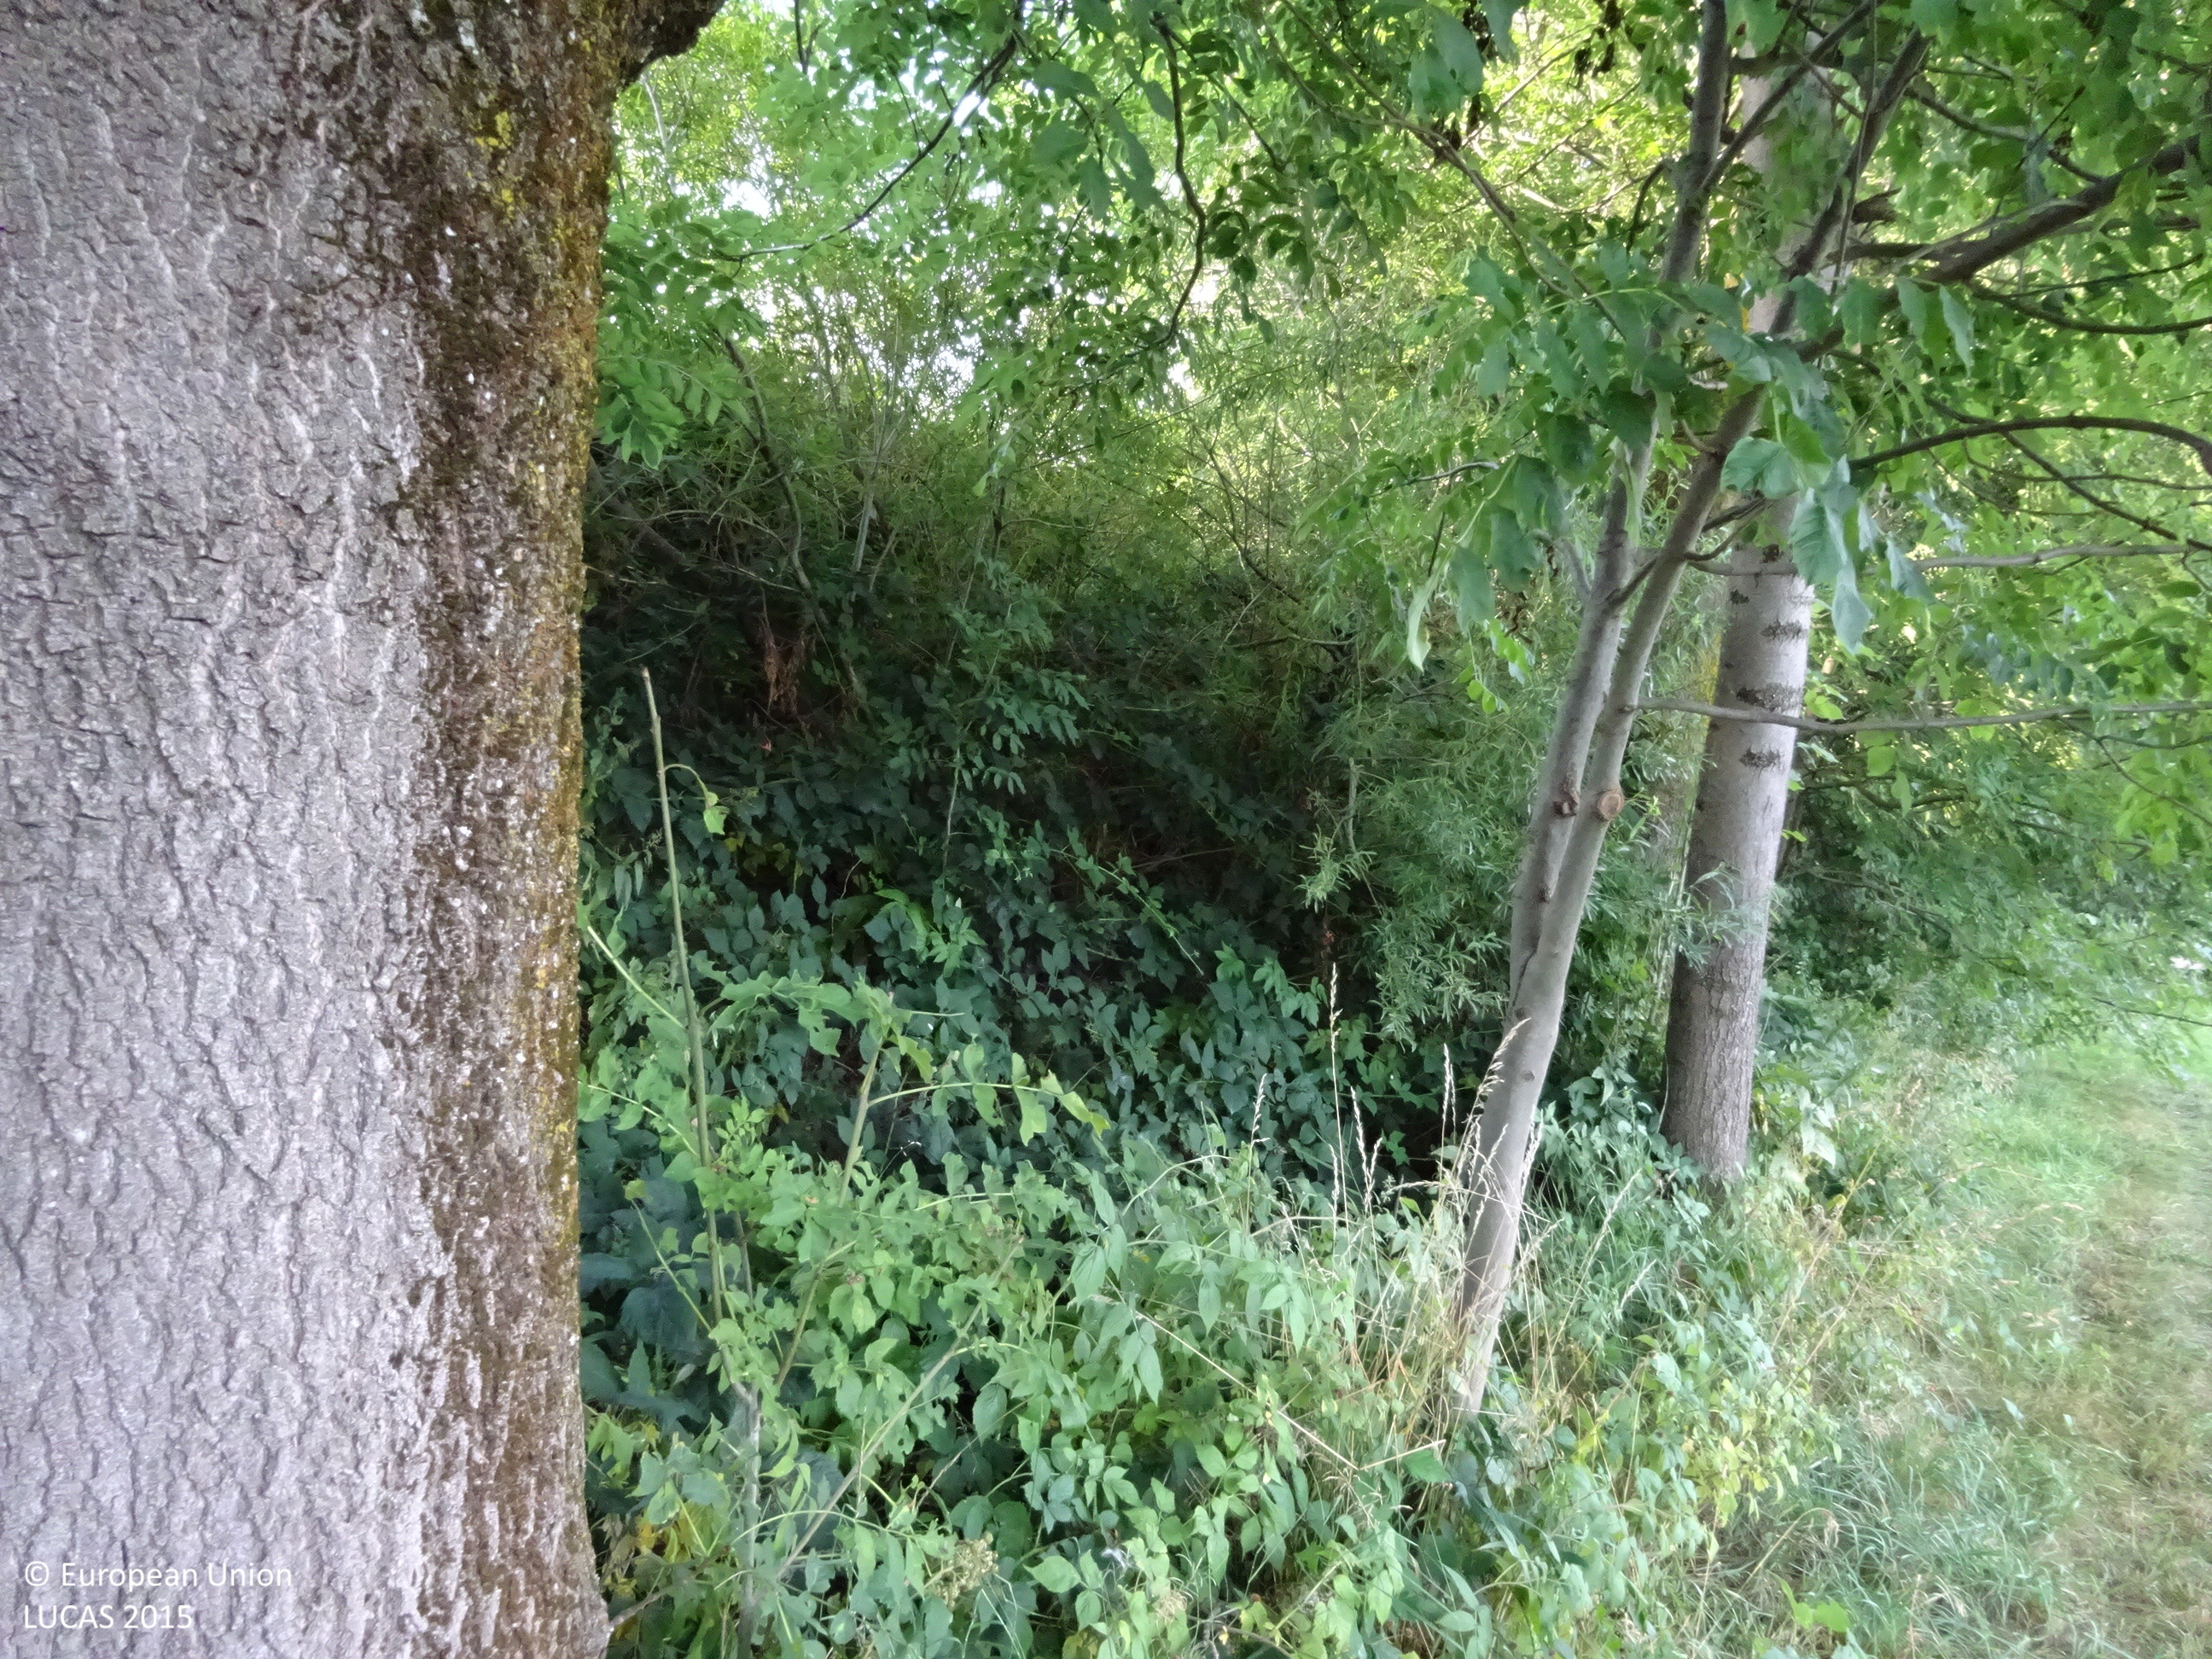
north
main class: Woodland
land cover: Broadleaved woodland
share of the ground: 50 - 75 %
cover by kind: broadleaved forest trees 50 %, herbaceous plants 50 %
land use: Semi-natural and natural areas not in use
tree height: > 5 m
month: August
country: AT
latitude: 47.4037
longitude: 15.7921
